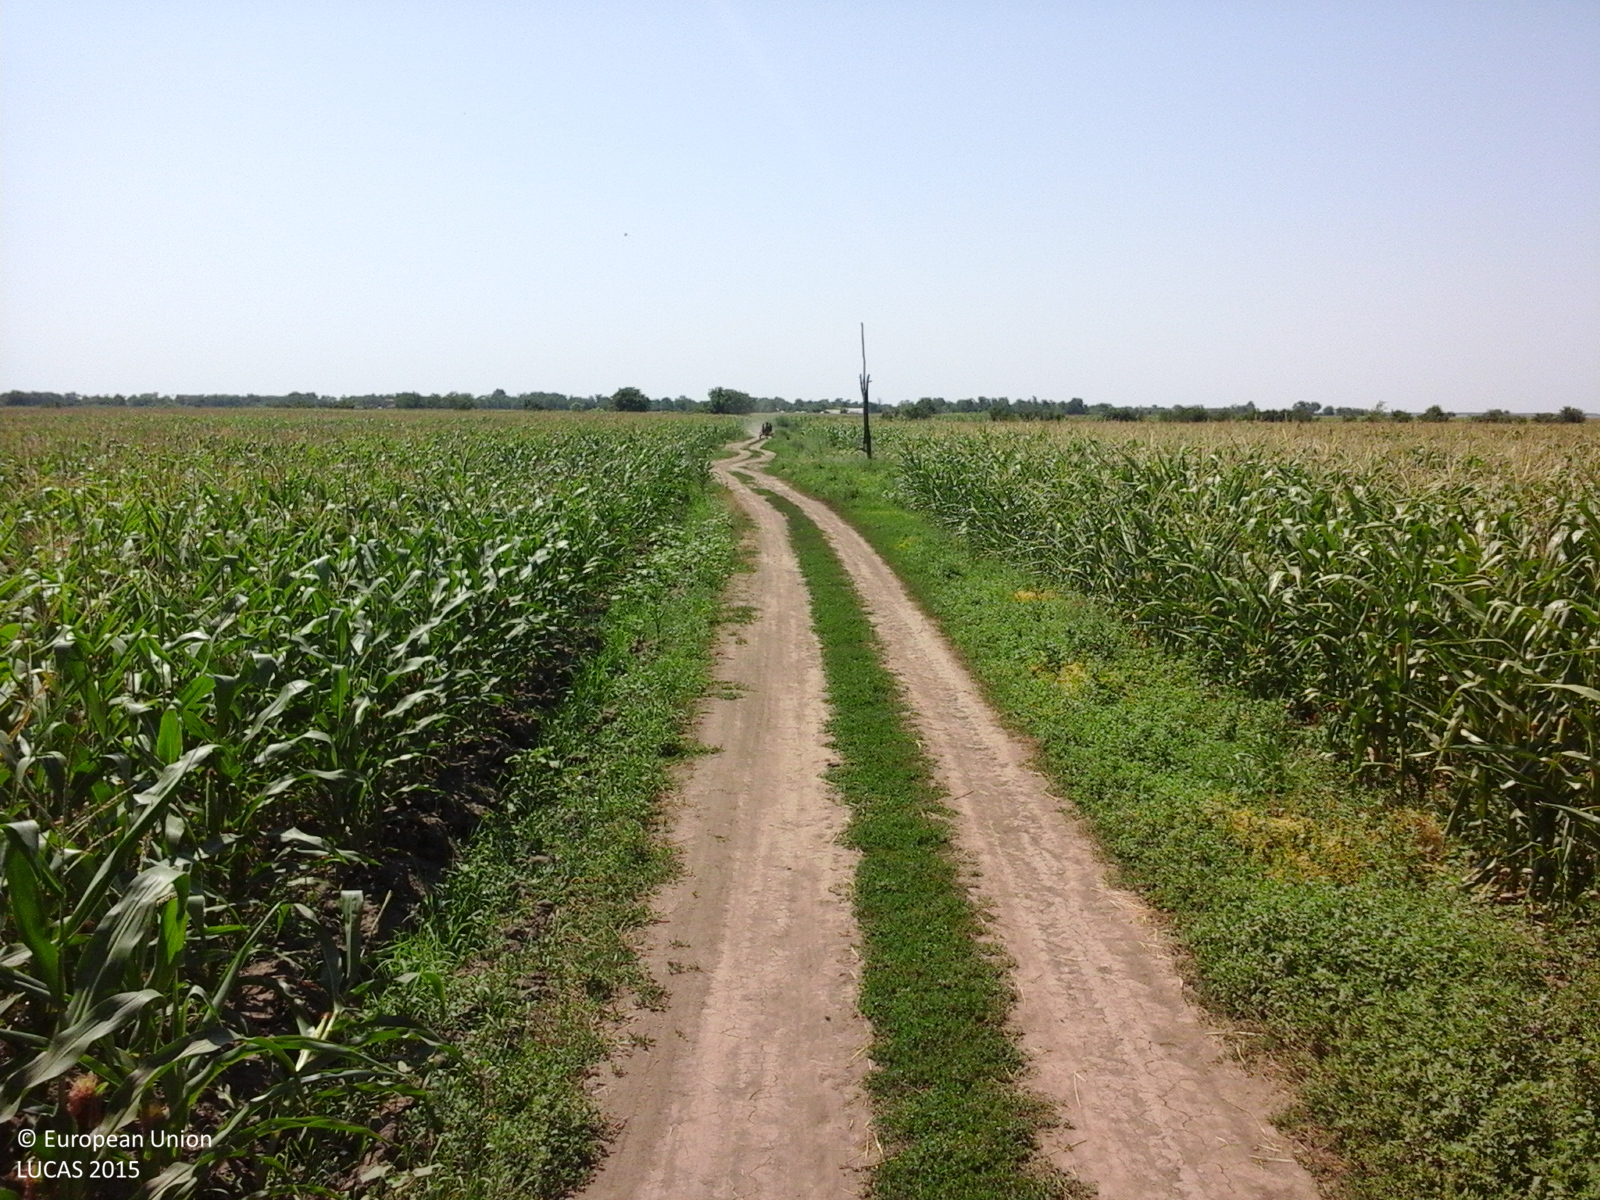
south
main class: Cropland
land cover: Maize
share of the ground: > 75 %
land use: Agriculture (excluding fallow land and kitchen gardens)
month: July
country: RO
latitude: 45.0167
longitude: 27.2076
